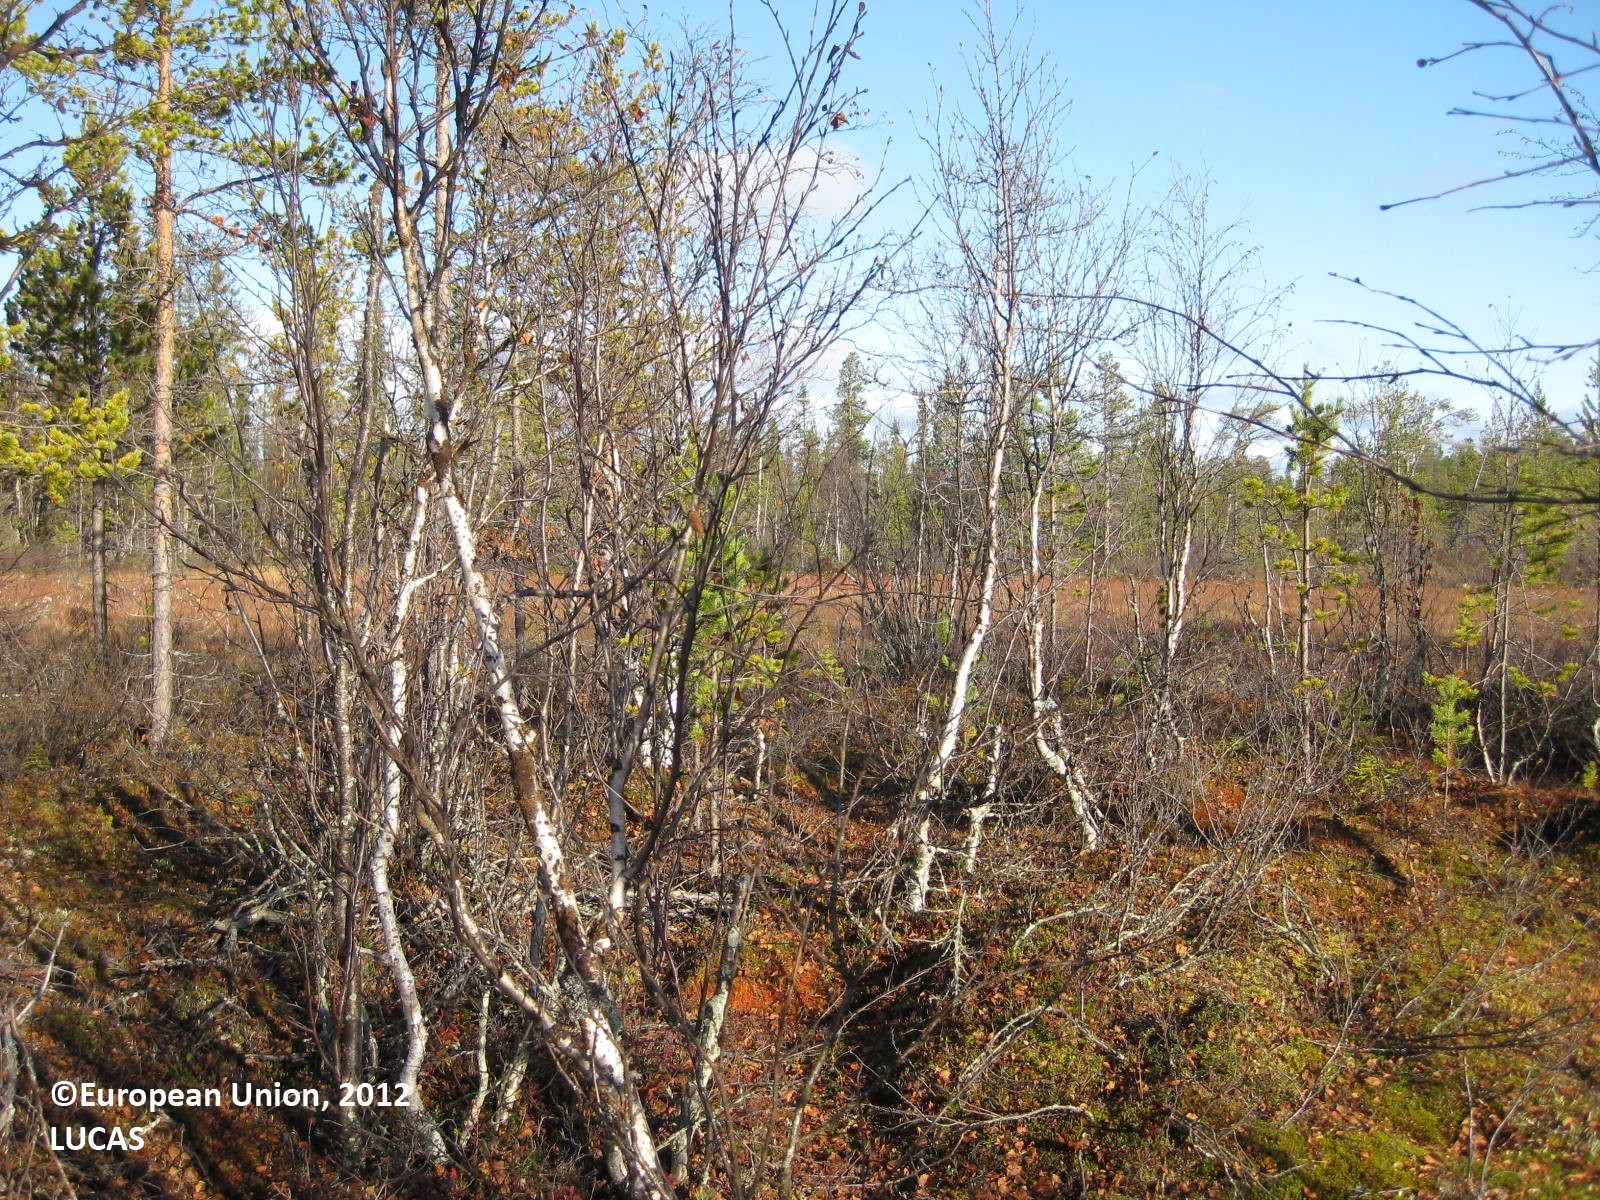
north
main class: Woodland
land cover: Other mixed woodland
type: boreal forest
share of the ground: > 75 %
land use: Forestry
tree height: > 5 m
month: September
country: FI
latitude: 67.9306
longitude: 23.6781
